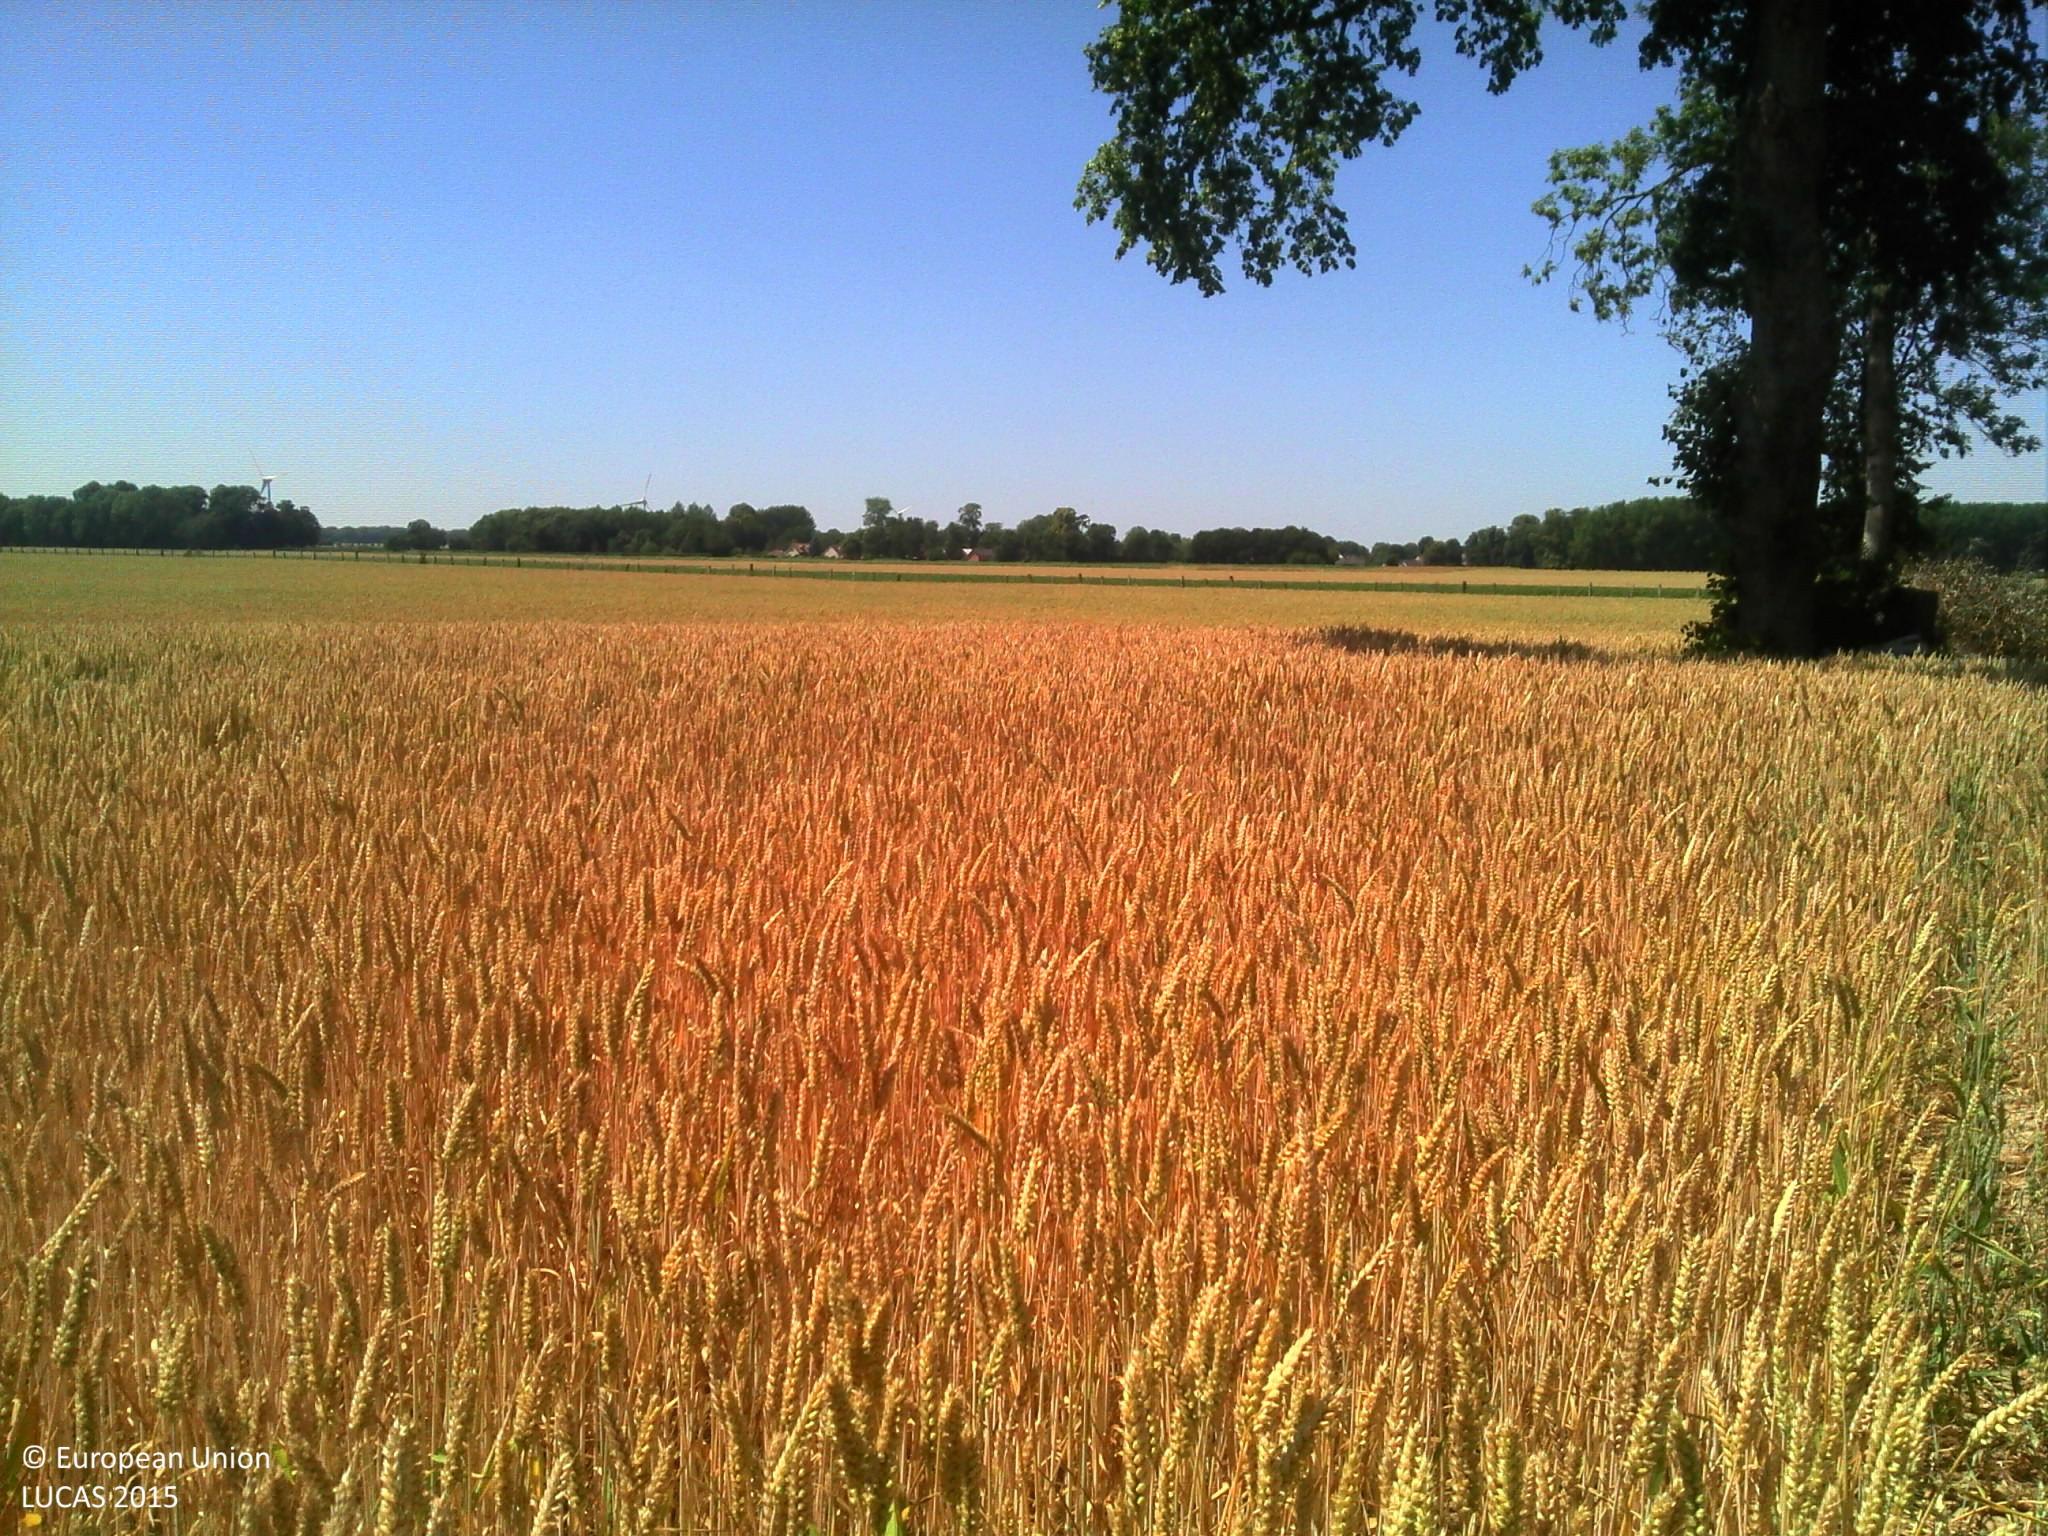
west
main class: Cropland
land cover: Common wheat
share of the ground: > 75 %
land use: Agriculture (excluding fallow land and kitchen gardens)
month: July
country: FR
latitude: 49.9370
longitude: 1.7205
